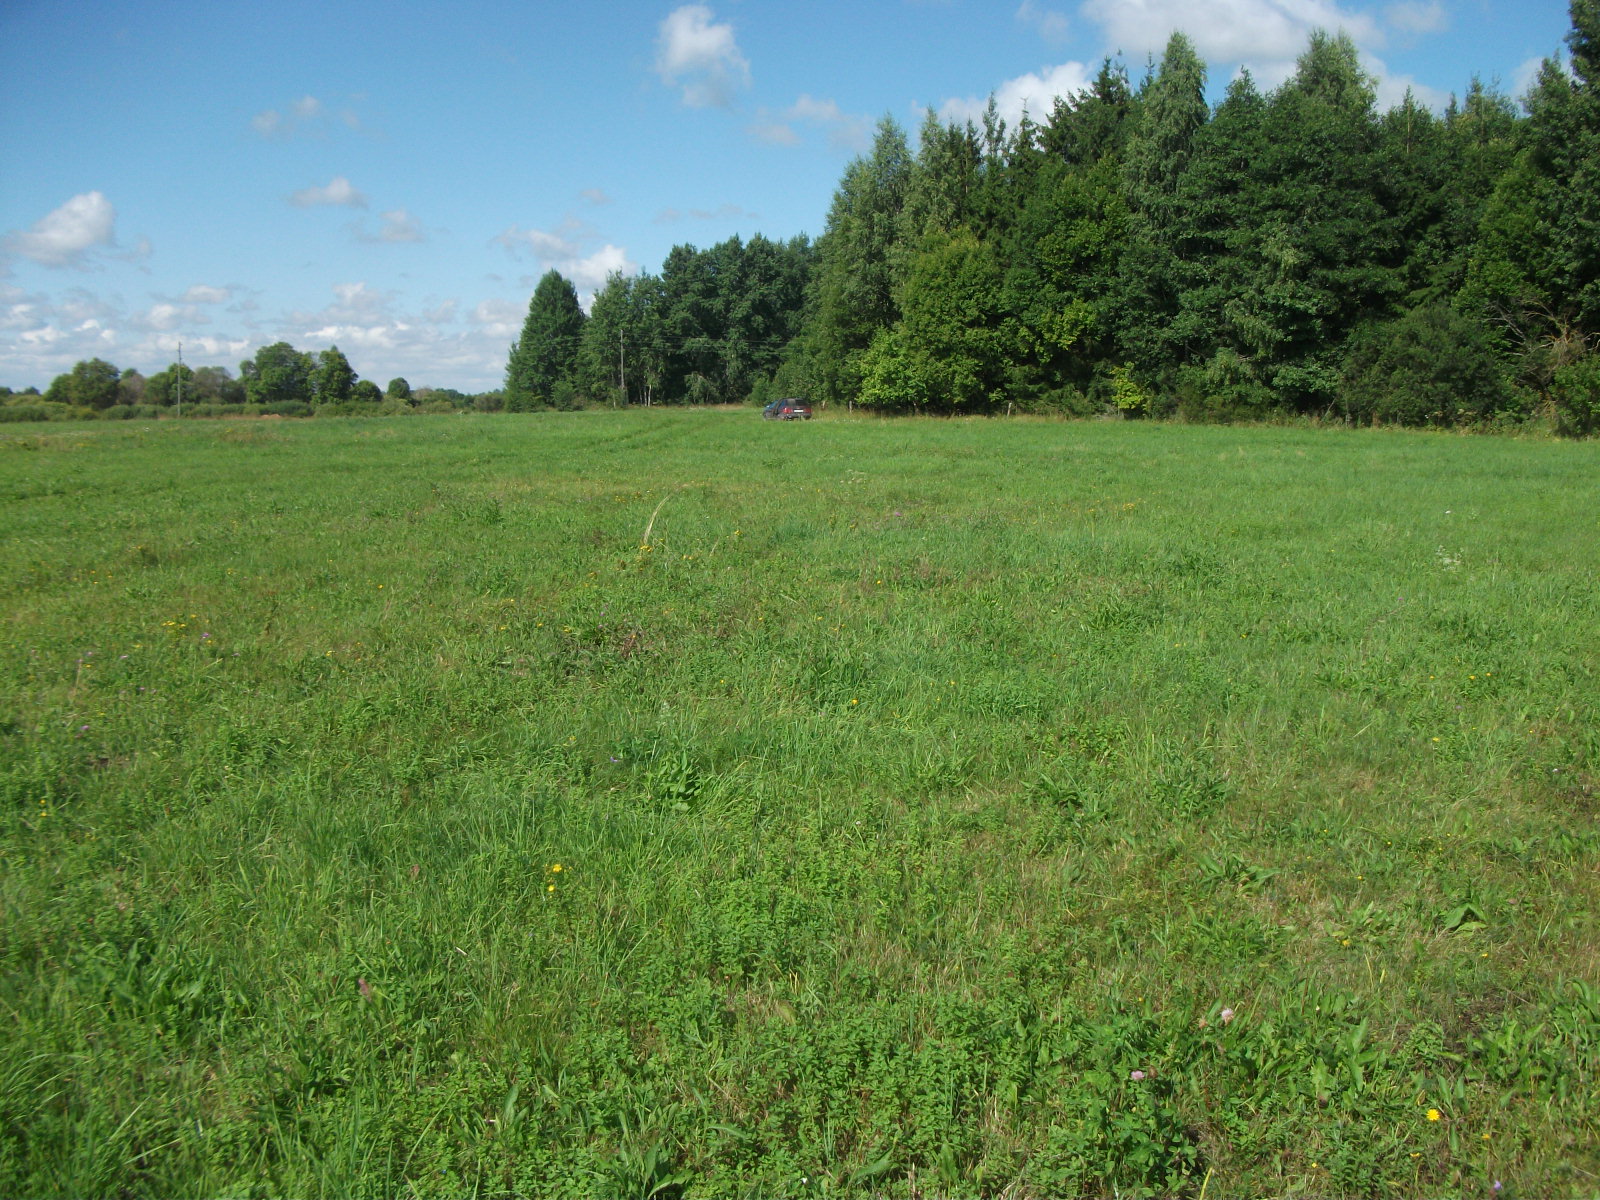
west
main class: Grassland
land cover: Grassland without tree/shrub cover
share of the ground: > 75 %
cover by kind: herbaceous plants 100 %
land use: Agriculture (excluding fallow land and kitchen gardens)
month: August
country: LV
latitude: 56.4443
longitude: 26.4158
